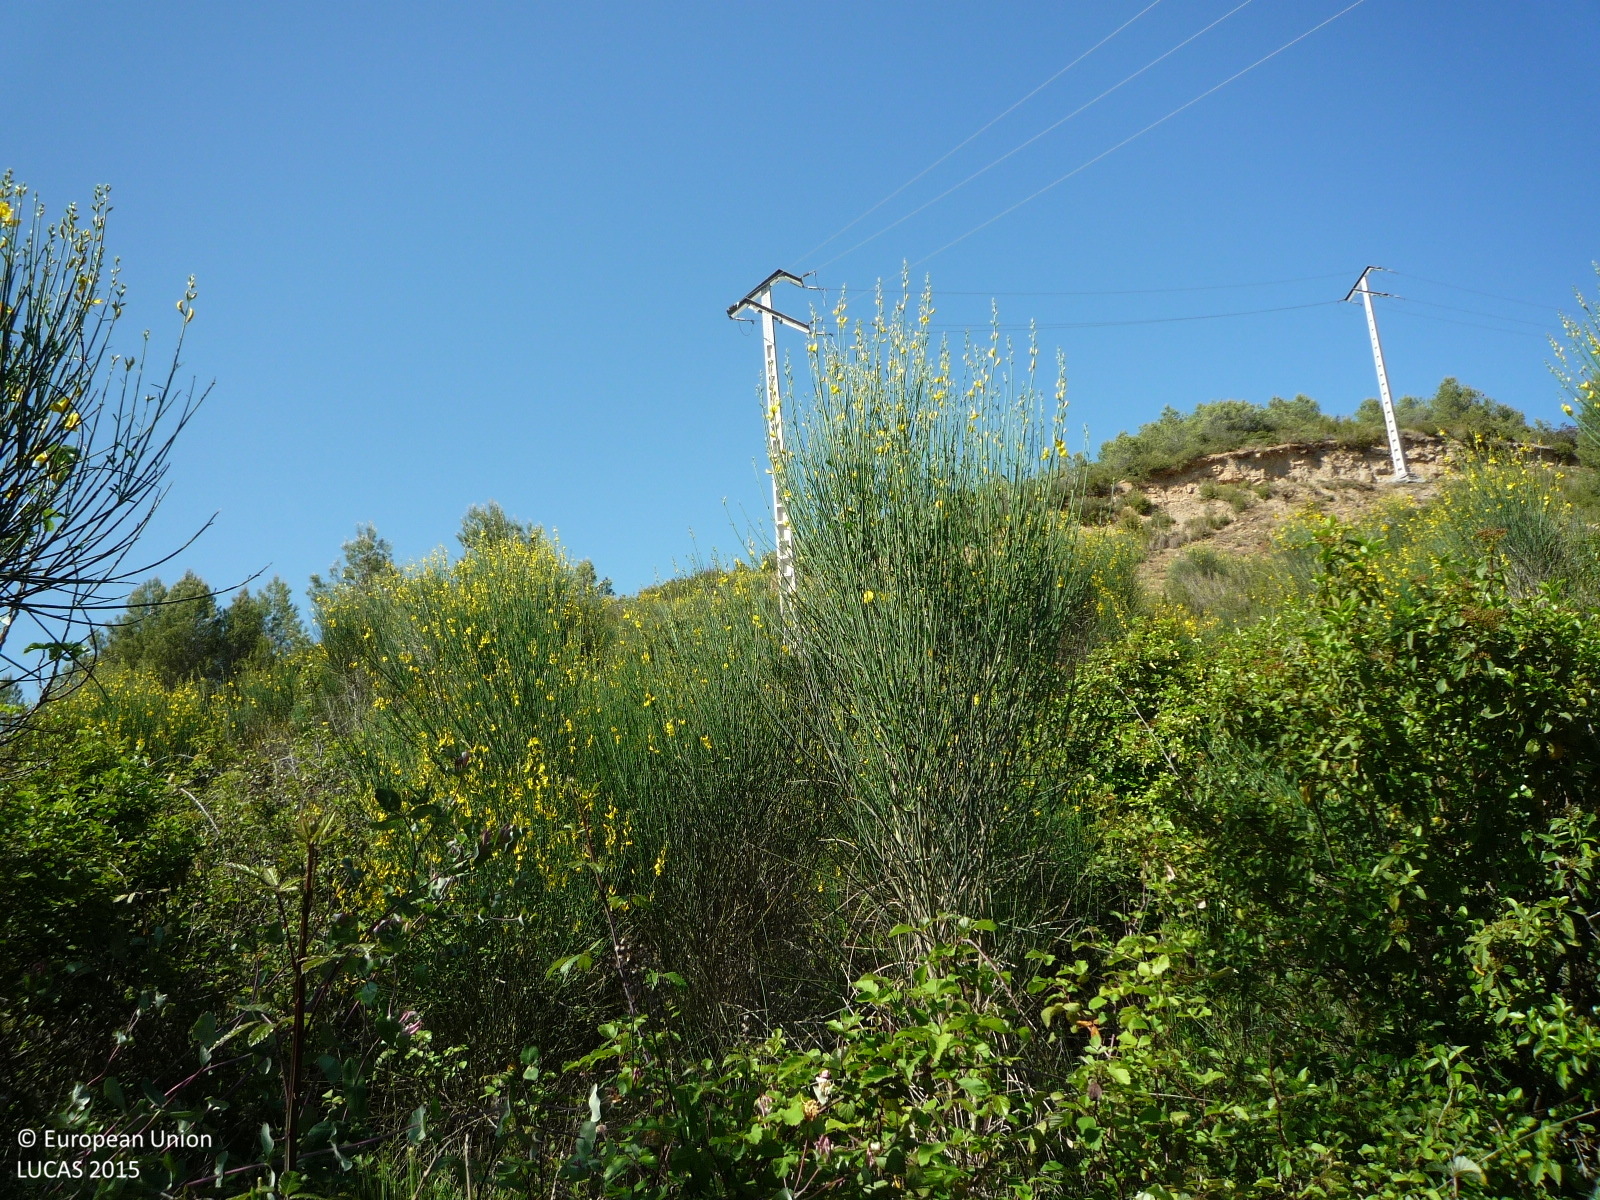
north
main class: Shrubland
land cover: Shrubland with sparse tree cover
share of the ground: > 75 %
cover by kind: shrubs 95 %, broadleaved forest trees 5 %
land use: Semi-natural and natural areas not in use
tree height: < 5 m
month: May
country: ES
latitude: 41.5007
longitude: 1.9787
